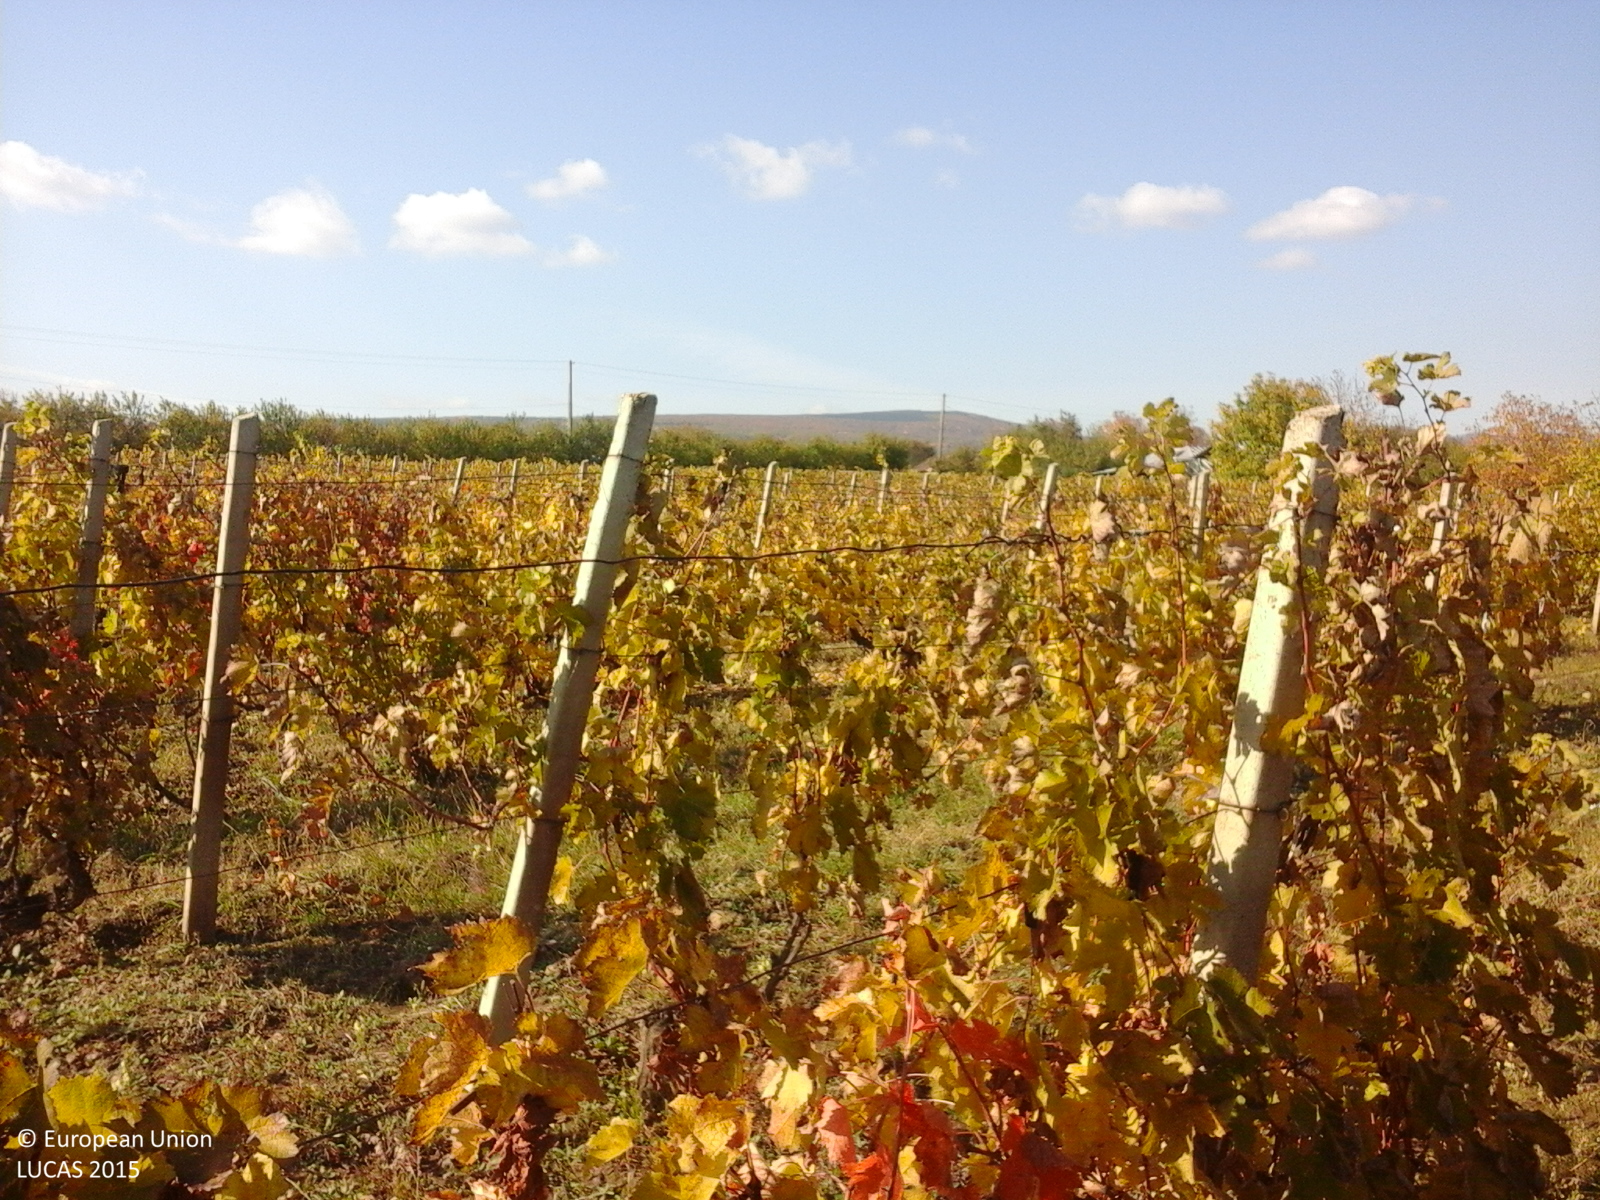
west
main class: Cropland
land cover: Vineyards
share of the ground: > 75 %
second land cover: Grassland without tree/shrub cover
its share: > 75 %
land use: Agriculture (excluding fallow land and kitchen gardens)
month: October
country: RO
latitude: 45.6646
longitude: 27.0722
